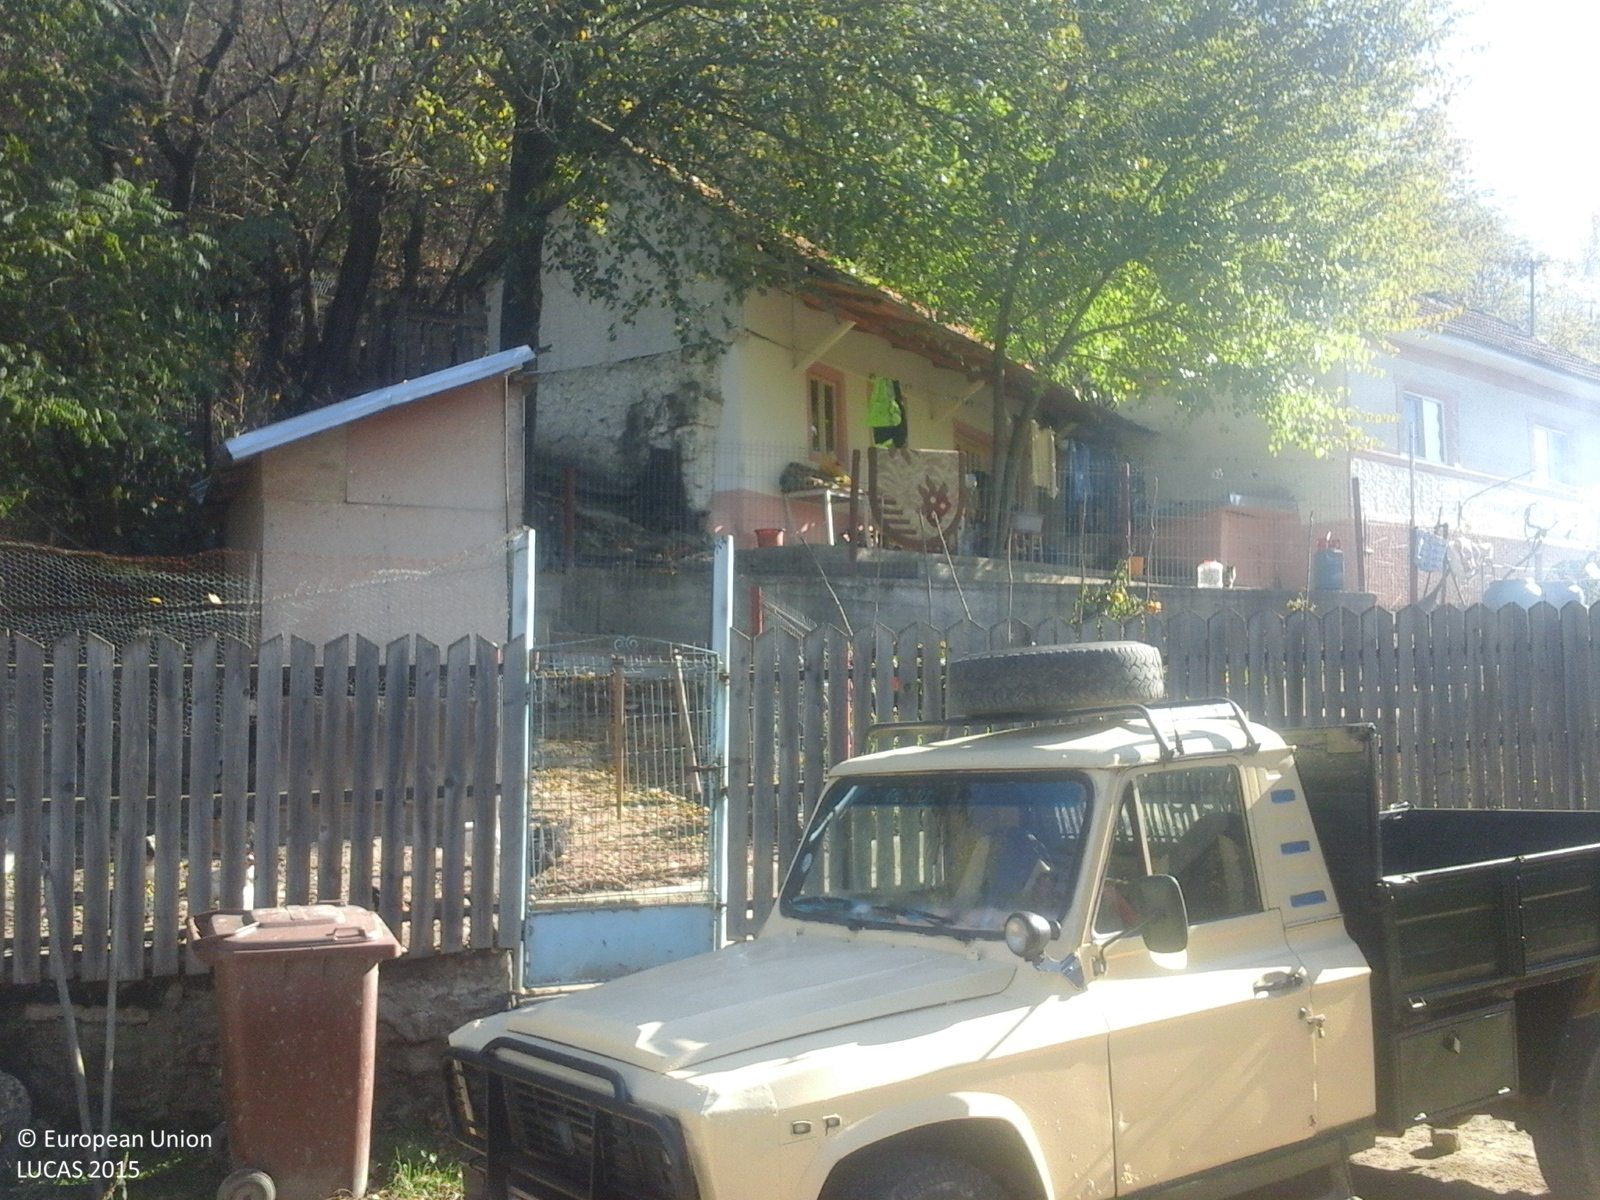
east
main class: Woodland
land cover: Broadleaved woodland
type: beech forest
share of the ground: > 75 %
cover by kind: broadleaved forest trees 100 %
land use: Forestry
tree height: > 5 m
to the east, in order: Broadleaved woodland; Tracks; Broadleaved woodland; Tracks; Electric lines; Broadleaved woodland
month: October
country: RO
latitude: 45.3729
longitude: 26.7170
